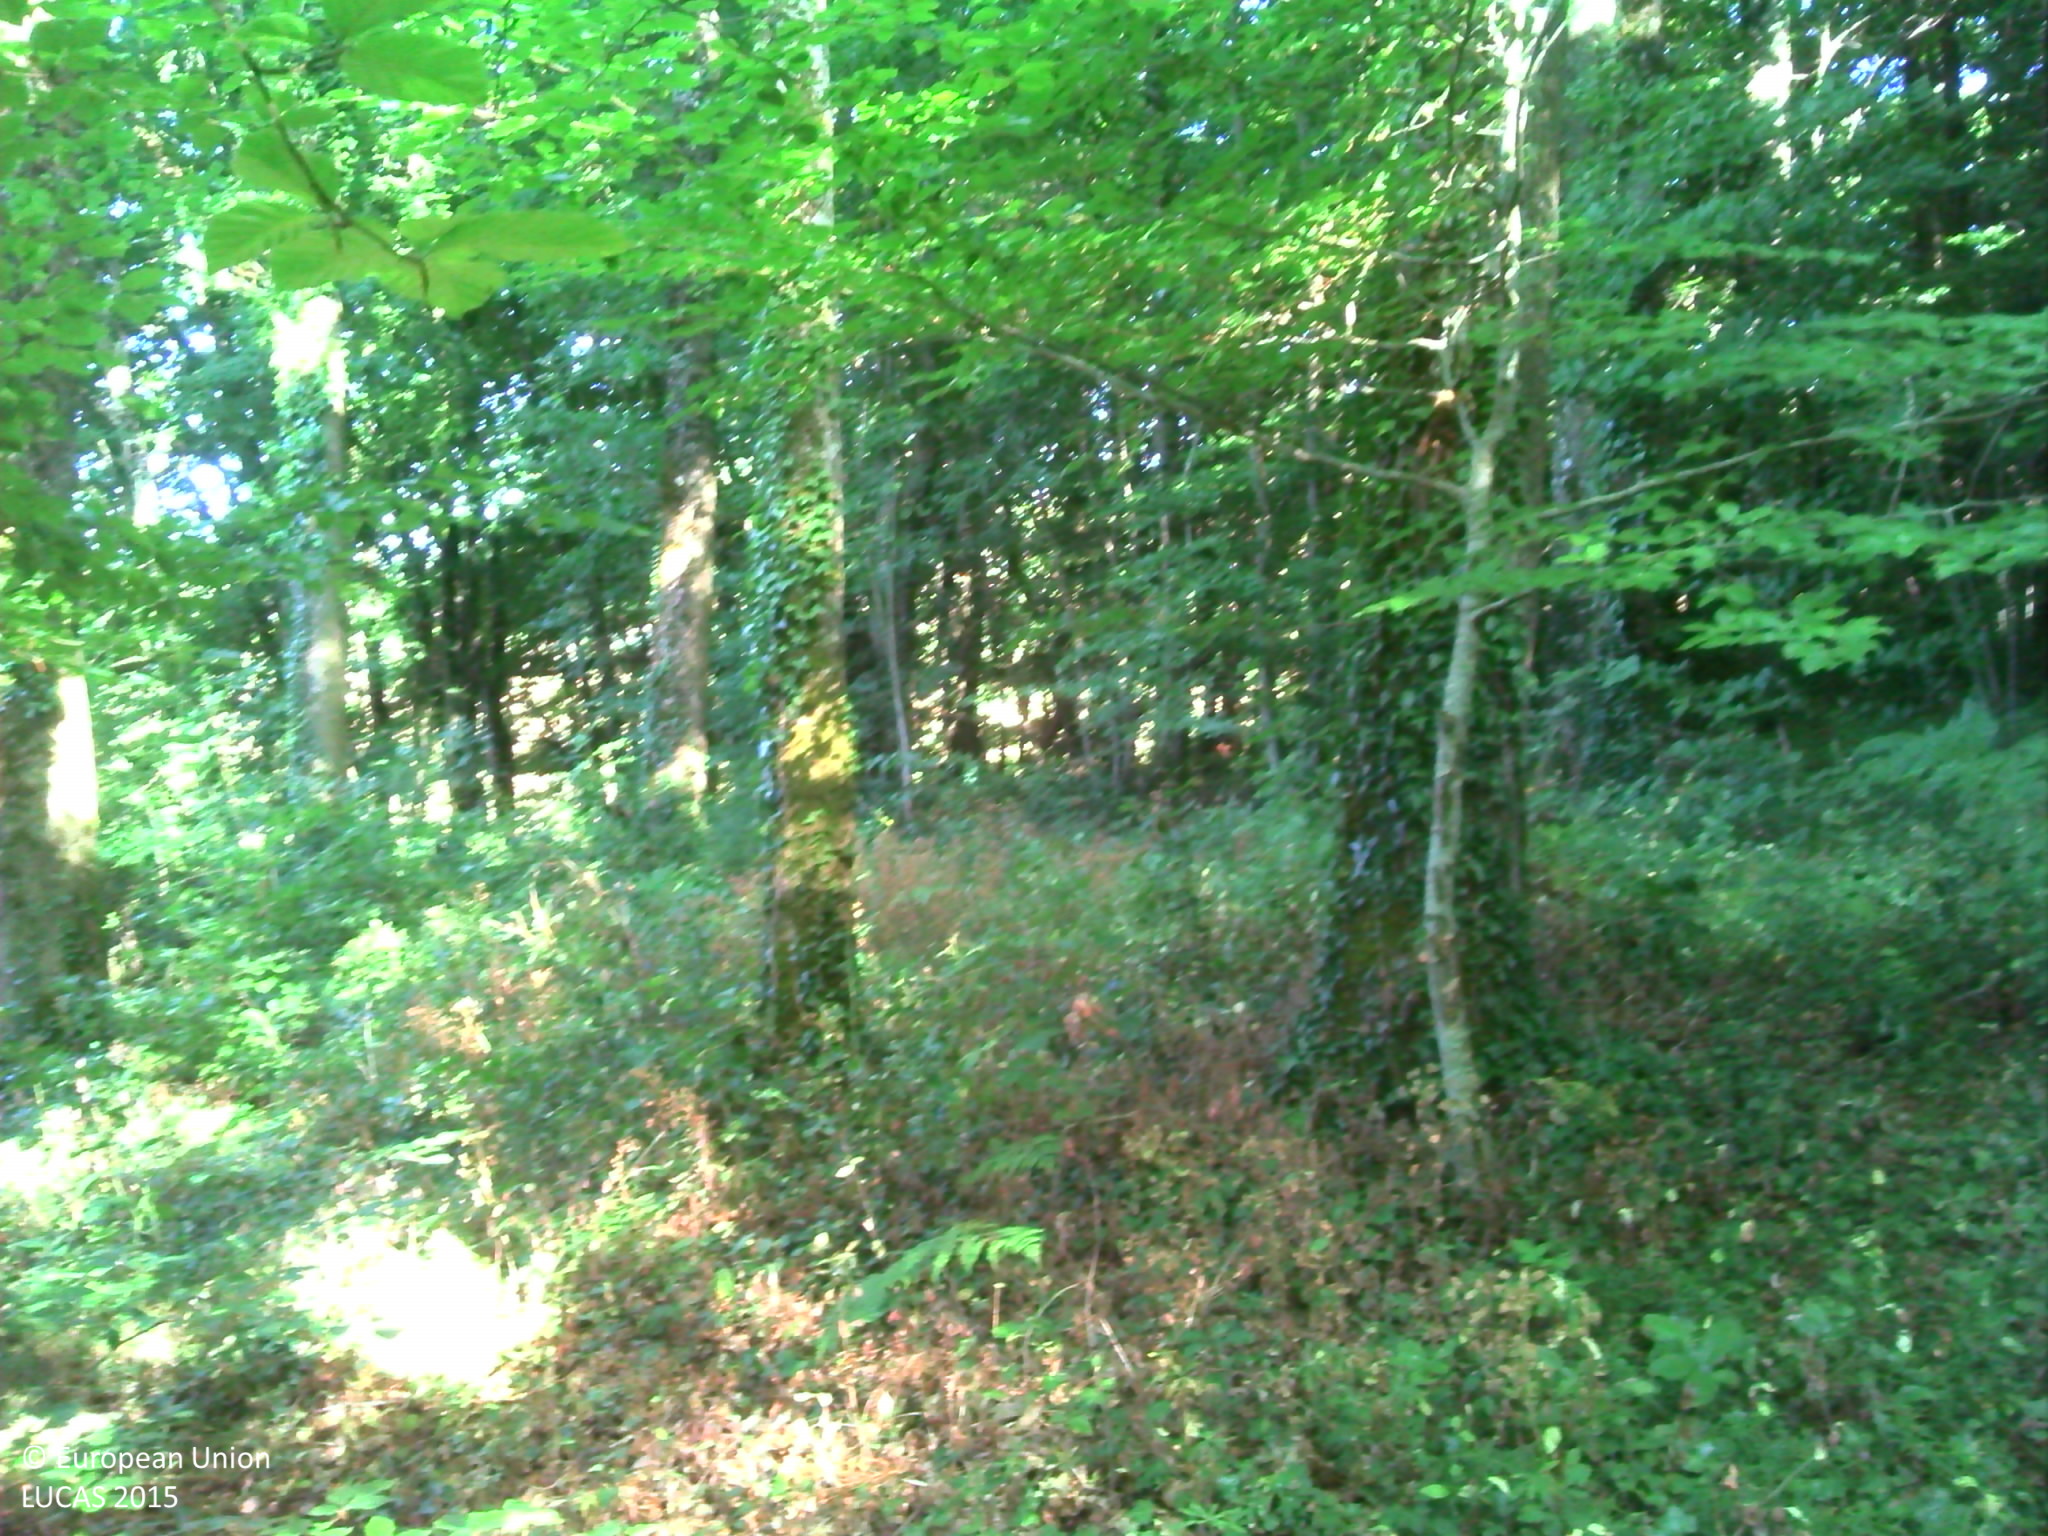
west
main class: Woodland
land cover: Broadleaved woodland
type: acidophilous oak and oak-birch forest
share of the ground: > 75 %
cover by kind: broadleaved forest trees 40 %, herbaceous plants 20 %, lichens and mosses 20 %, unconsolidated bare surface 20 %
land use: Forestry
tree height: > 5 m
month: July
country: FR
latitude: 45.6828
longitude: 1.4545
